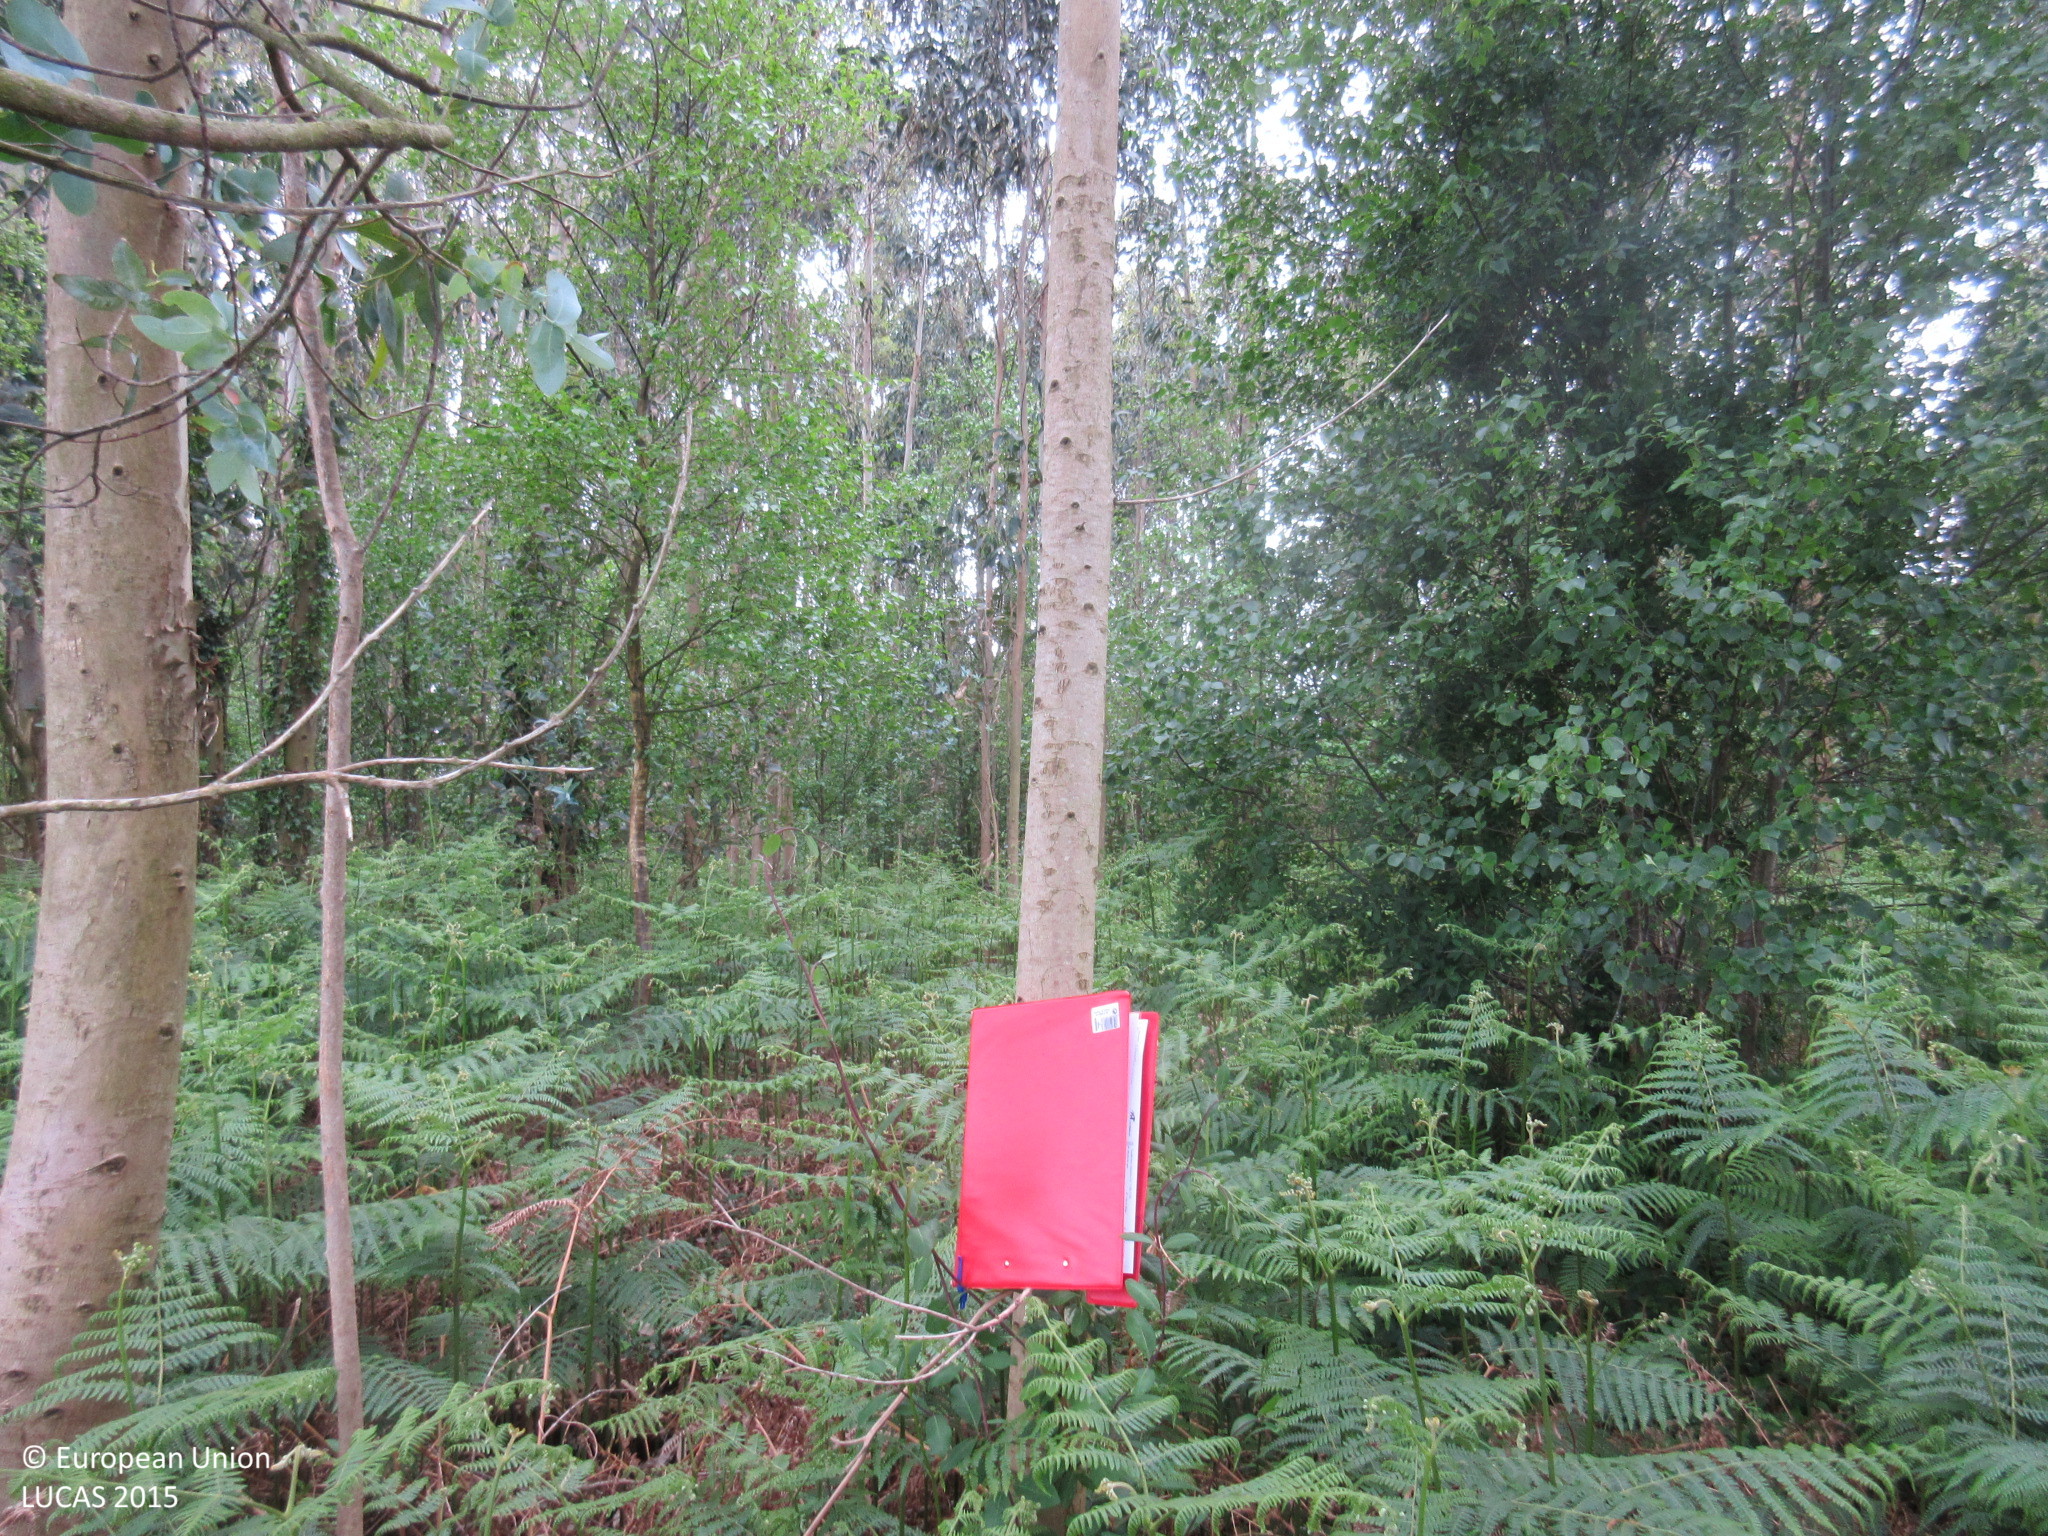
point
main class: Woodland
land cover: Broadleaved woodland
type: exotic forest
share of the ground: > 75 %
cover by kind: broadleaved forest trees 95 %, shrubs 5 %
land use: Forestry
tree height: > 5 m
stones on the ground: < 10 %
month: April
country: ES
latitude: 43.5418
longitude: -7.1132
